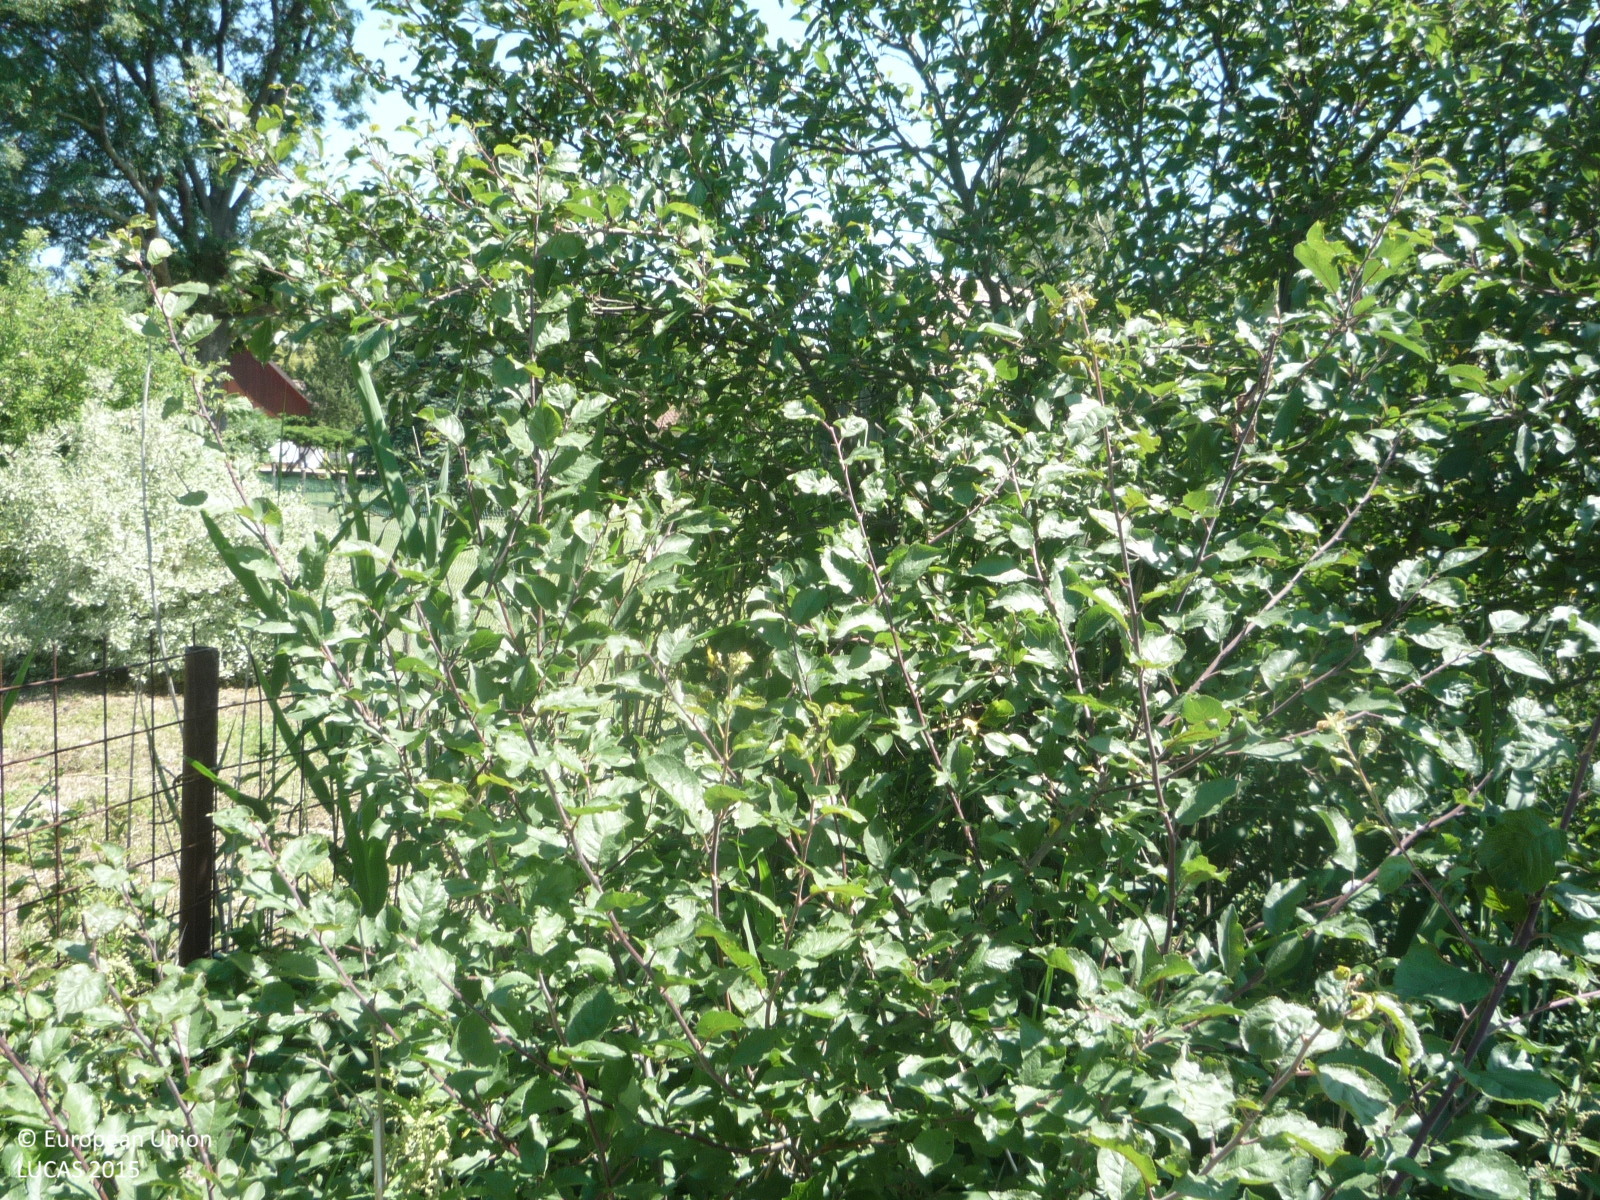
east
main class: Grassland
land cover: Grassland without tree/shrub cover
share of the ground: > 75 %
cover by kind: herbaceous plants 100 %
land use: Amenities, museums, leisure
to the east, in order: Grassland without tree/shrub cover; Artificial constructions in urban areas
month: July
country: CZ
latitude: 50.2648
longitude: 15.1798
